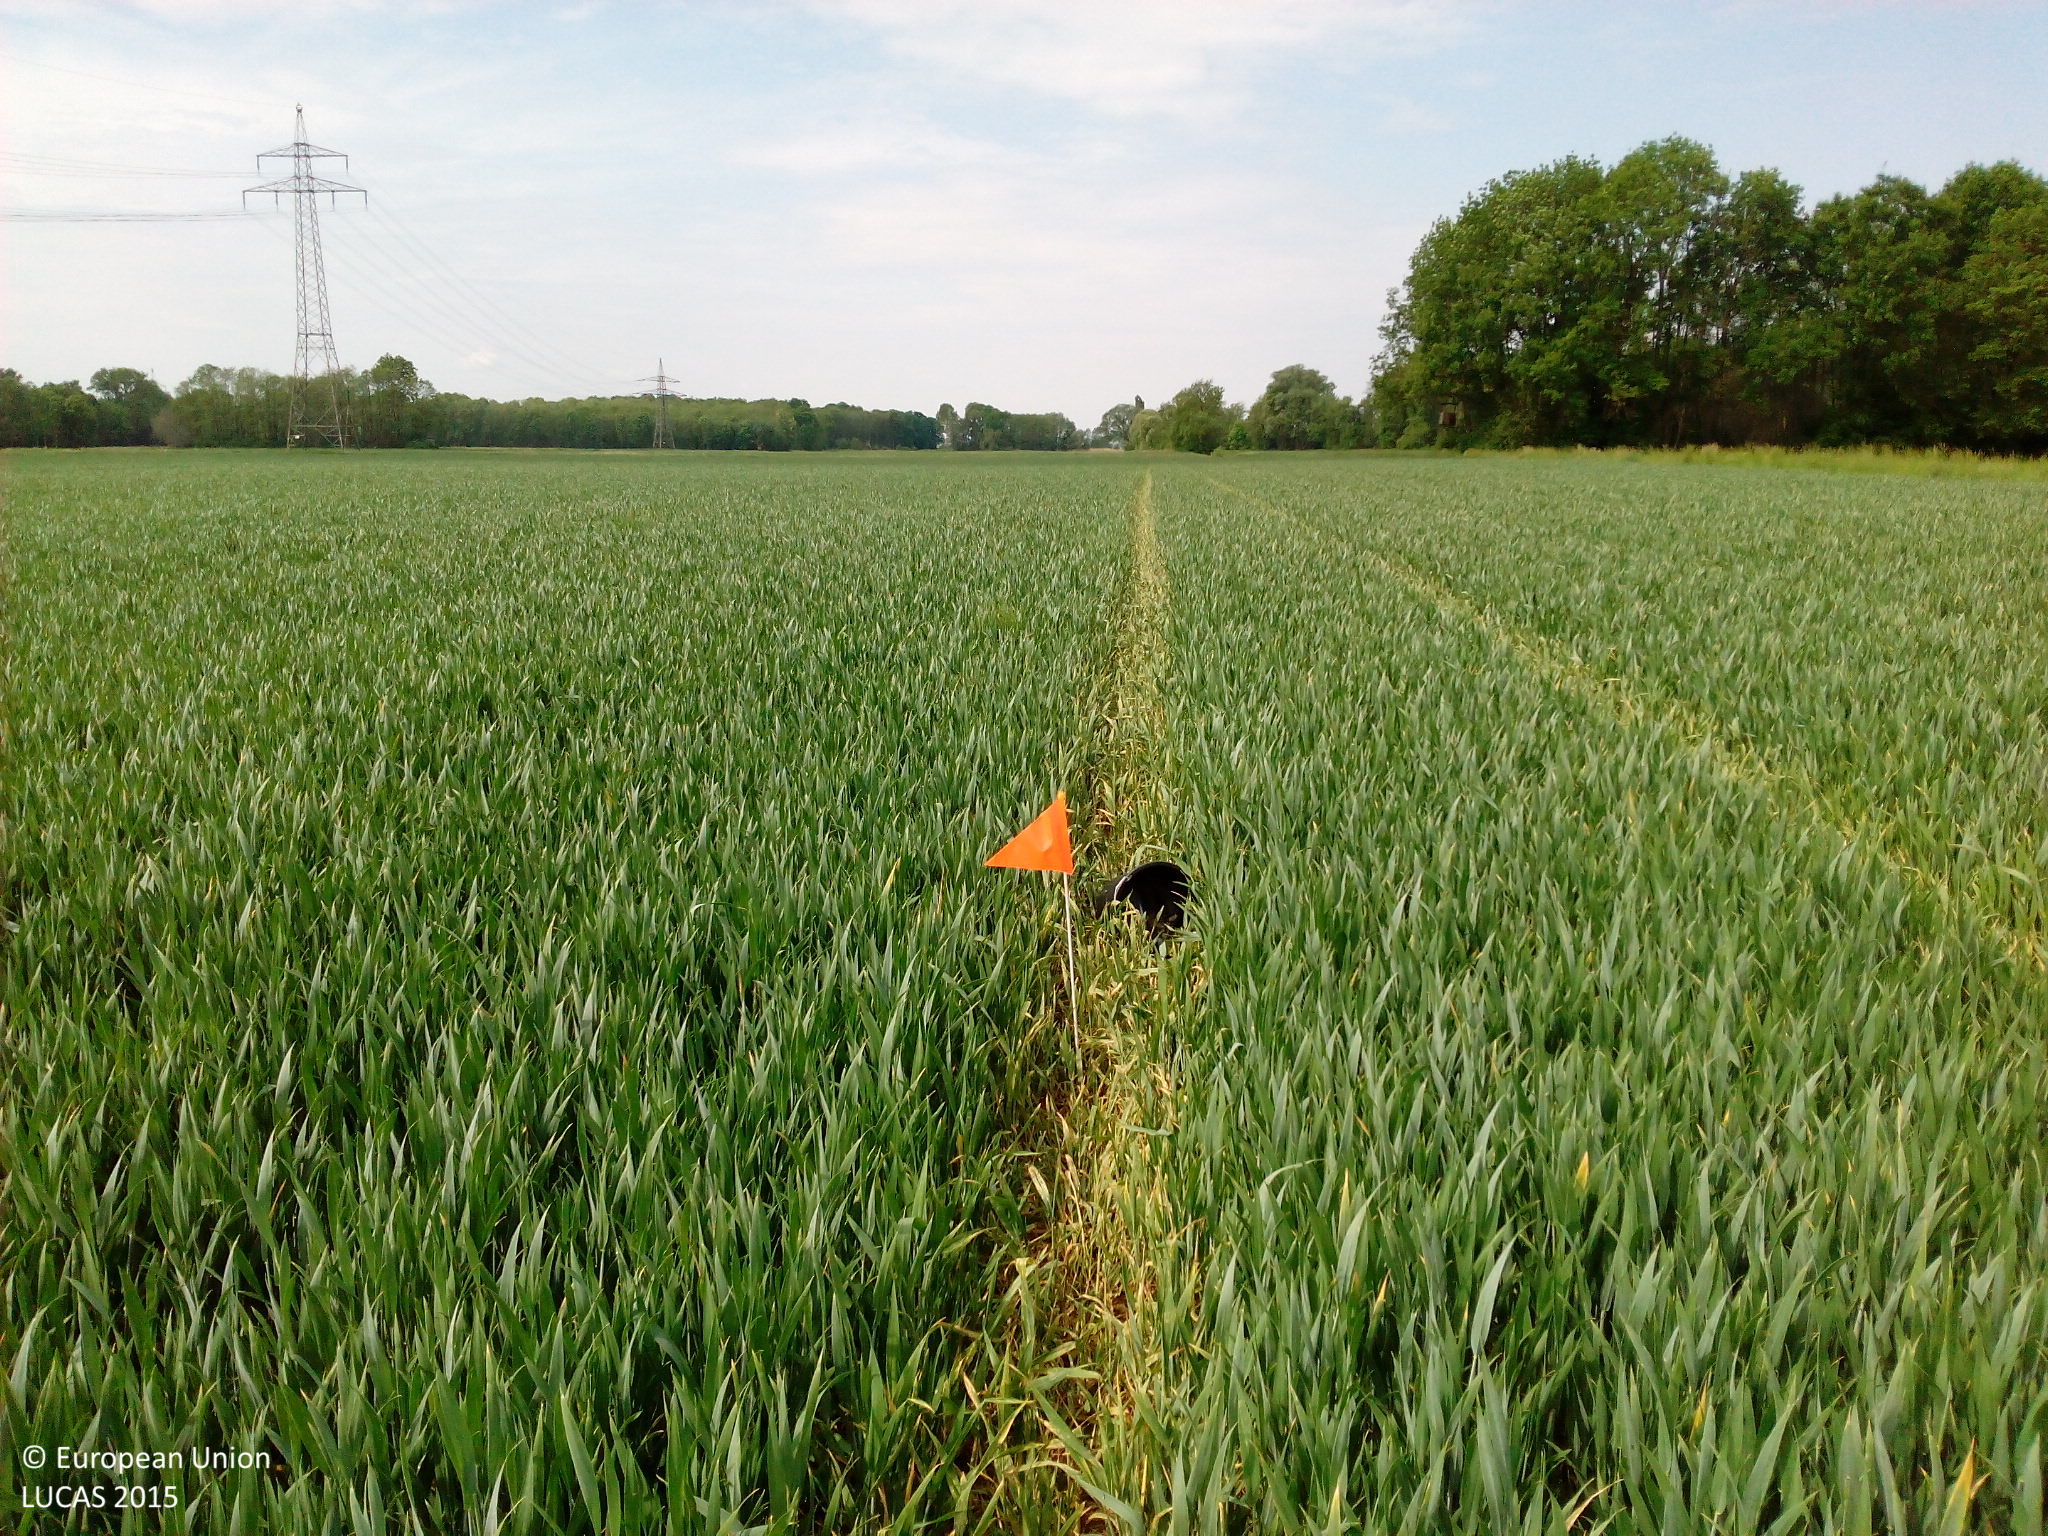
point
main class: Cropland
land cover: Common wheat
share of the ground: > 75 %
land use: Agriculture (excluding fallow land and kitchen gardens)
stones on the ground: < 10 %
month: May
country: DE
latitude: 48.9363
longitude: 12.3611
